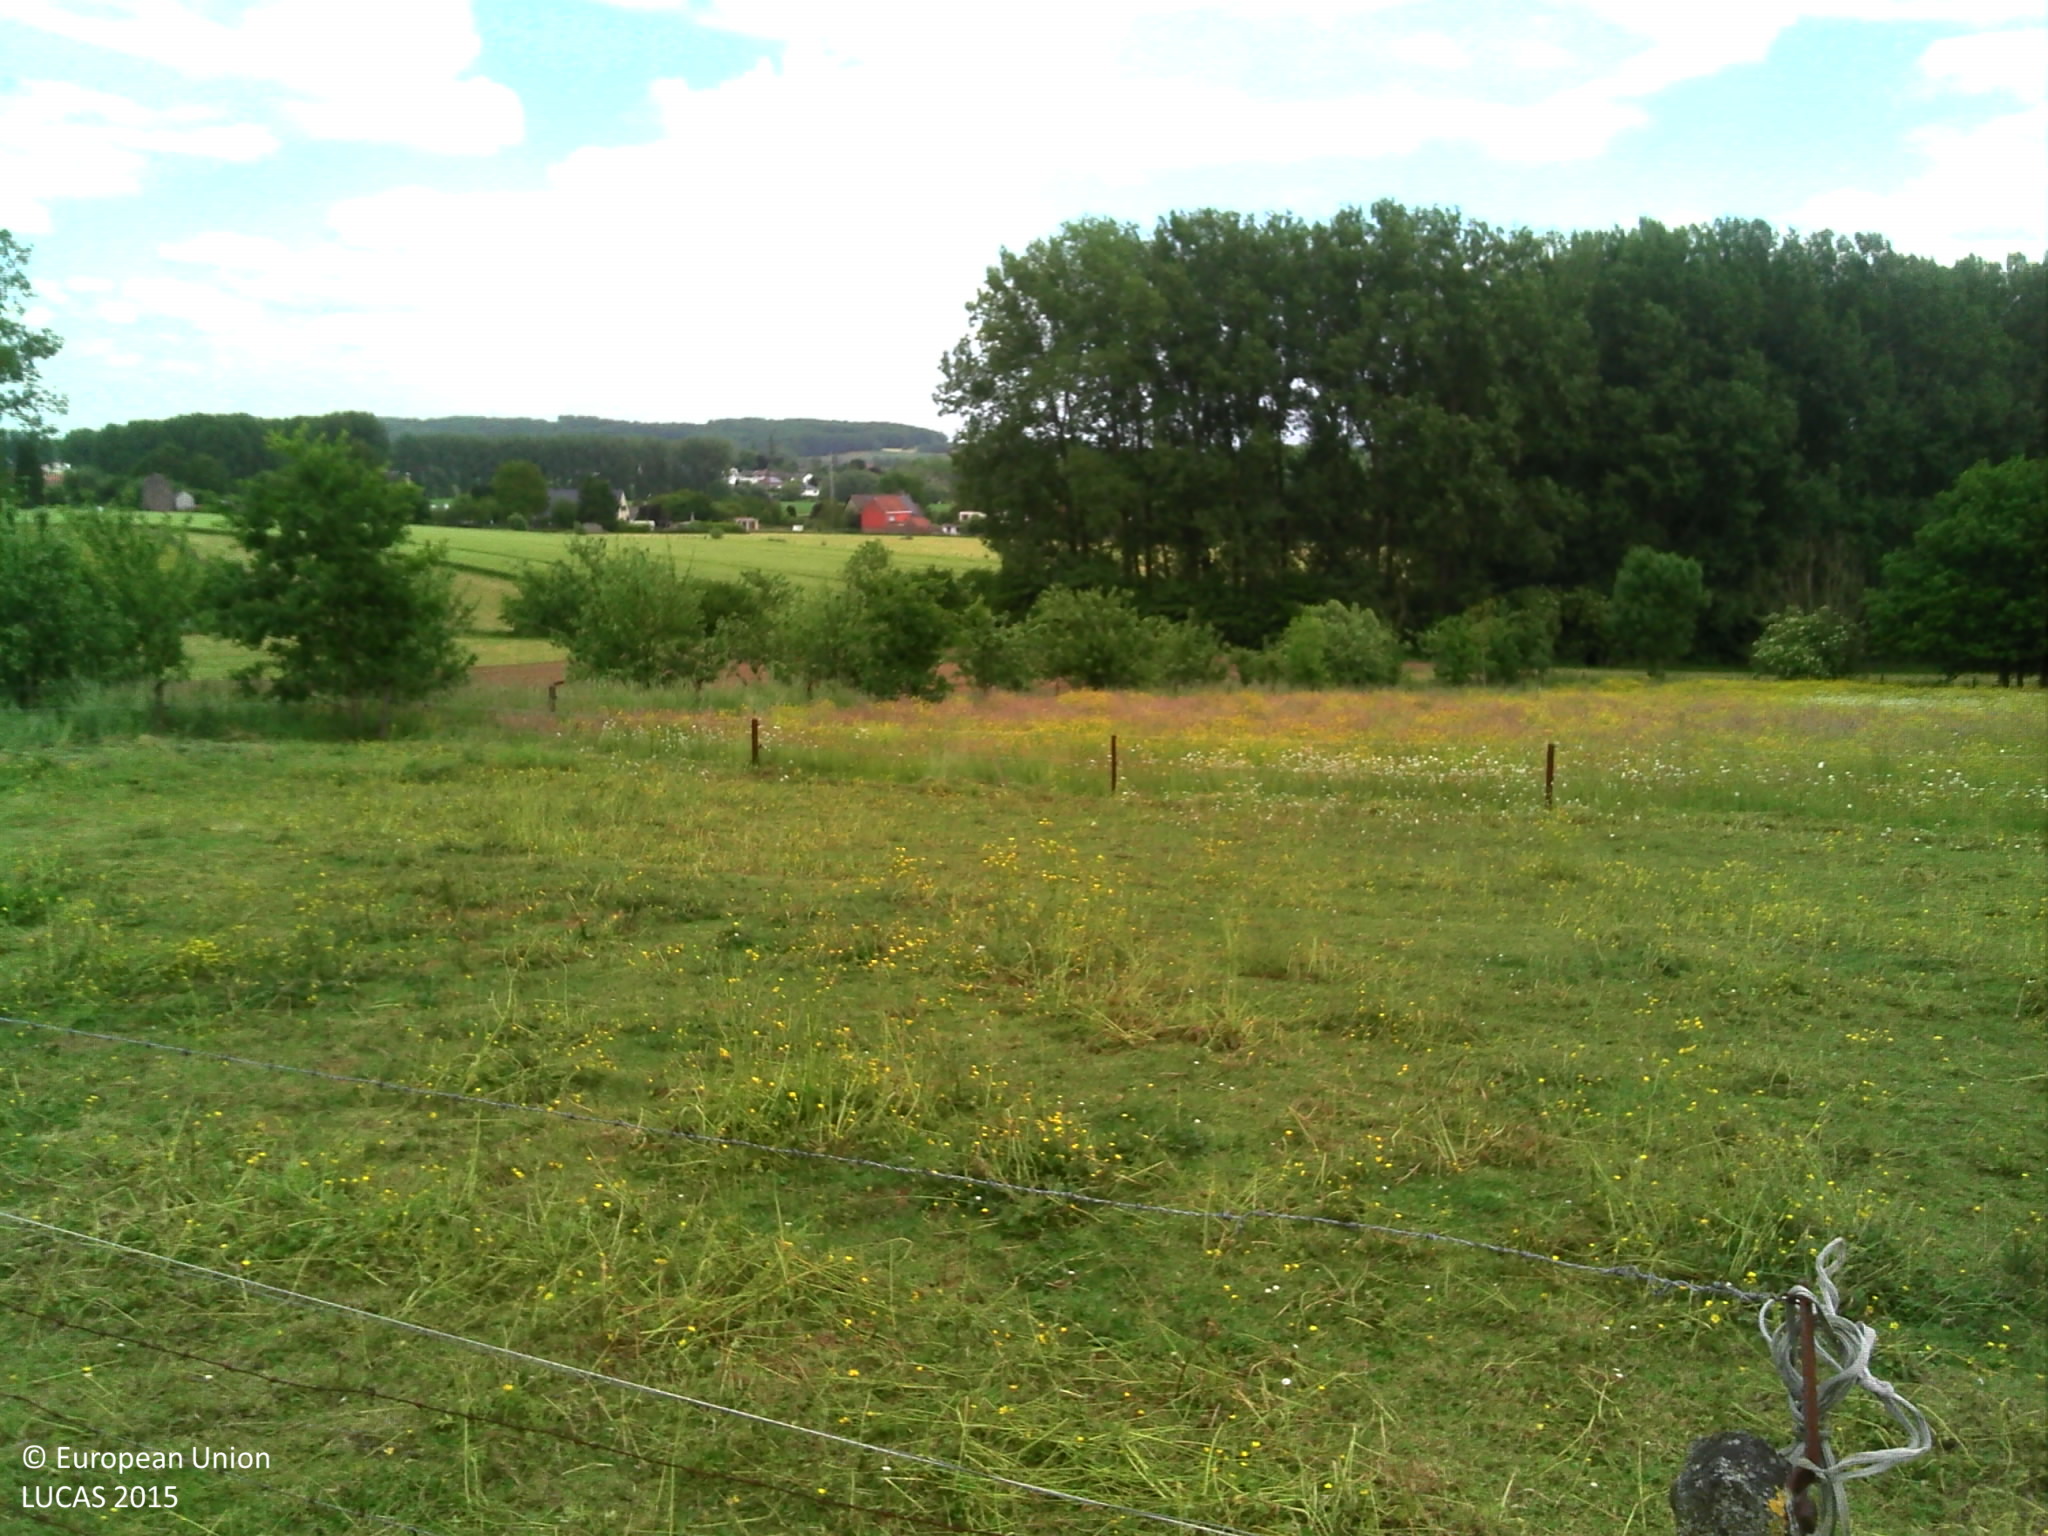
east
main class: Grassland
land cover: Grassland with sparse tree/shrub cover
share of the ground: > 75 %
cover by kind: herbaceous plants 95 %, broadleaved forest trees 5 %
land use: Residential
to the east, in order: Grassland with sparse tree/shrub cover; Lines of trees; Fences; Grass margins; Fences; Grassland without tree/shrub cover; Fences; Grassland without tree/shrub cover; Fences; Grassland with sparse tree/shrub cover; Maize; Tracks; Broadleaved woodland; Barley
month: June
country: BE
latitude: 50.7594
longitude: 3.8837
